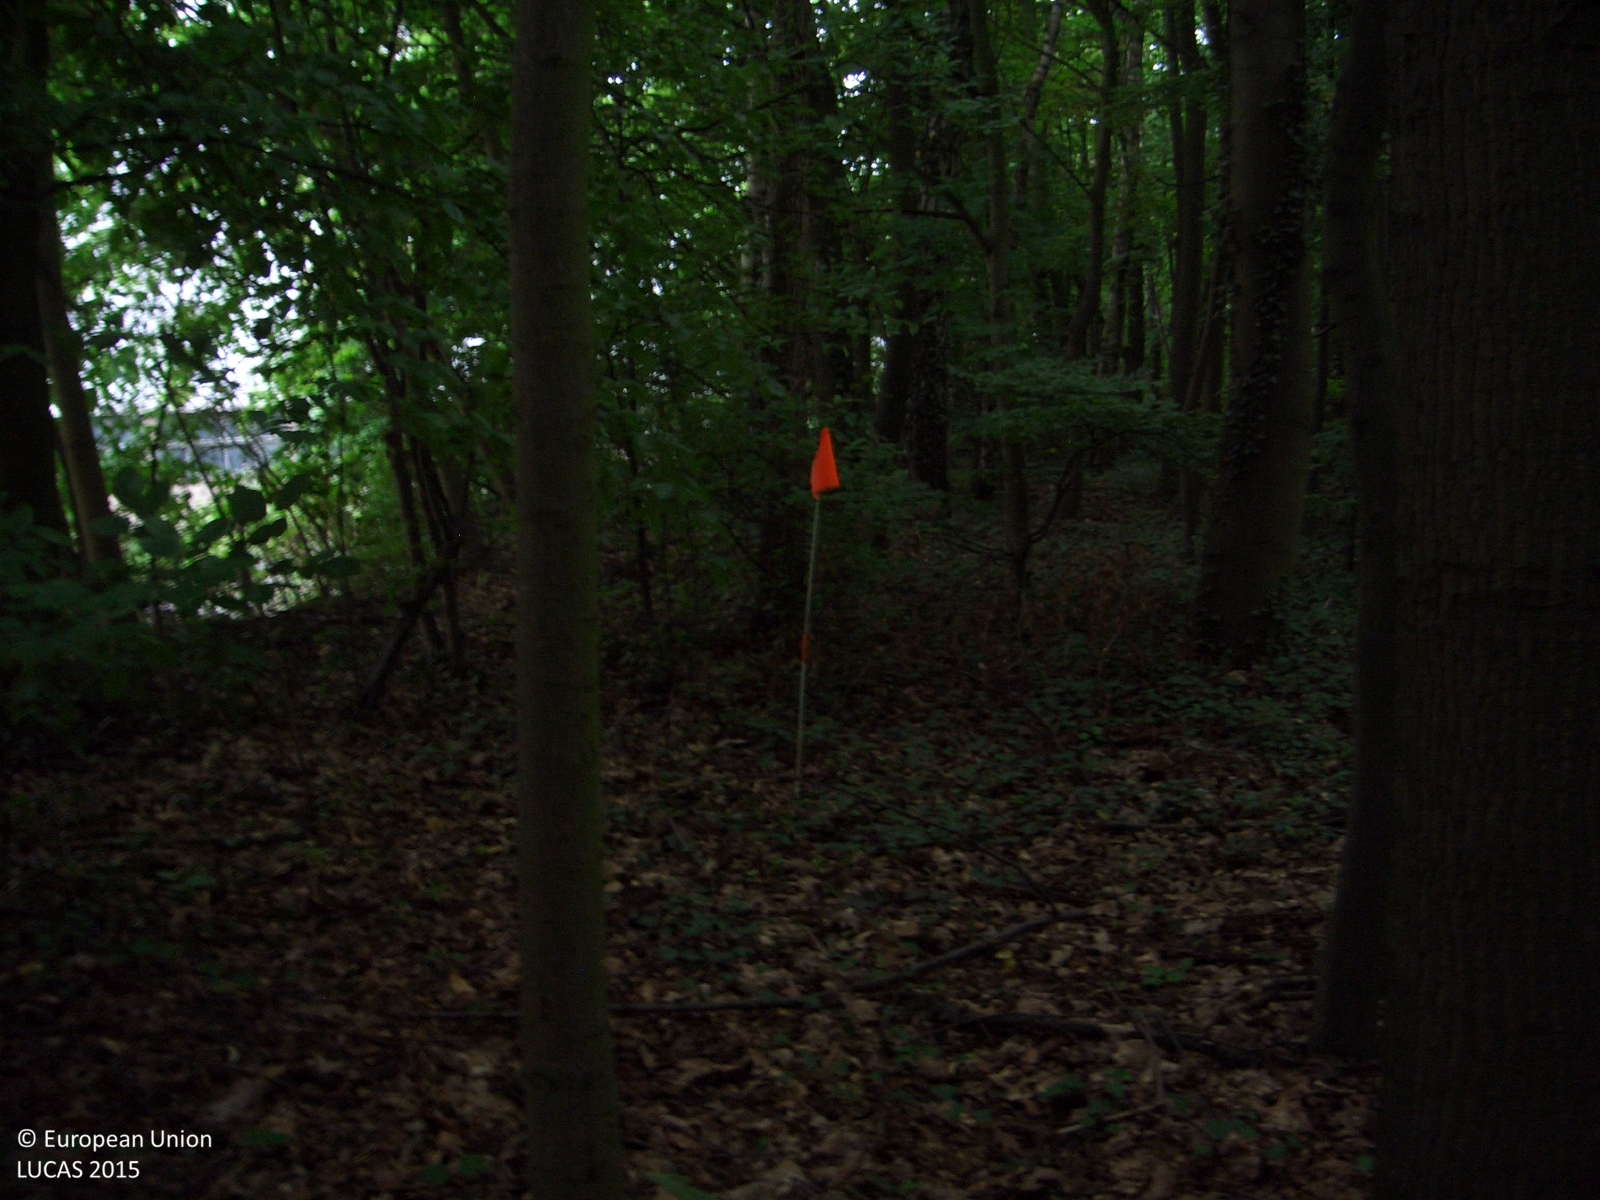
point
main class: Woodland
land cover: Broadleaved woodland
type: mesophytic deciduous forest
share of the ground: > 75 %
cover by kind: broadleaved forest trees 100 %
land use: Energy production
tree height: > 5 m
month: July
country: DE
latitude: 51.6024
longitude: 7.0114
